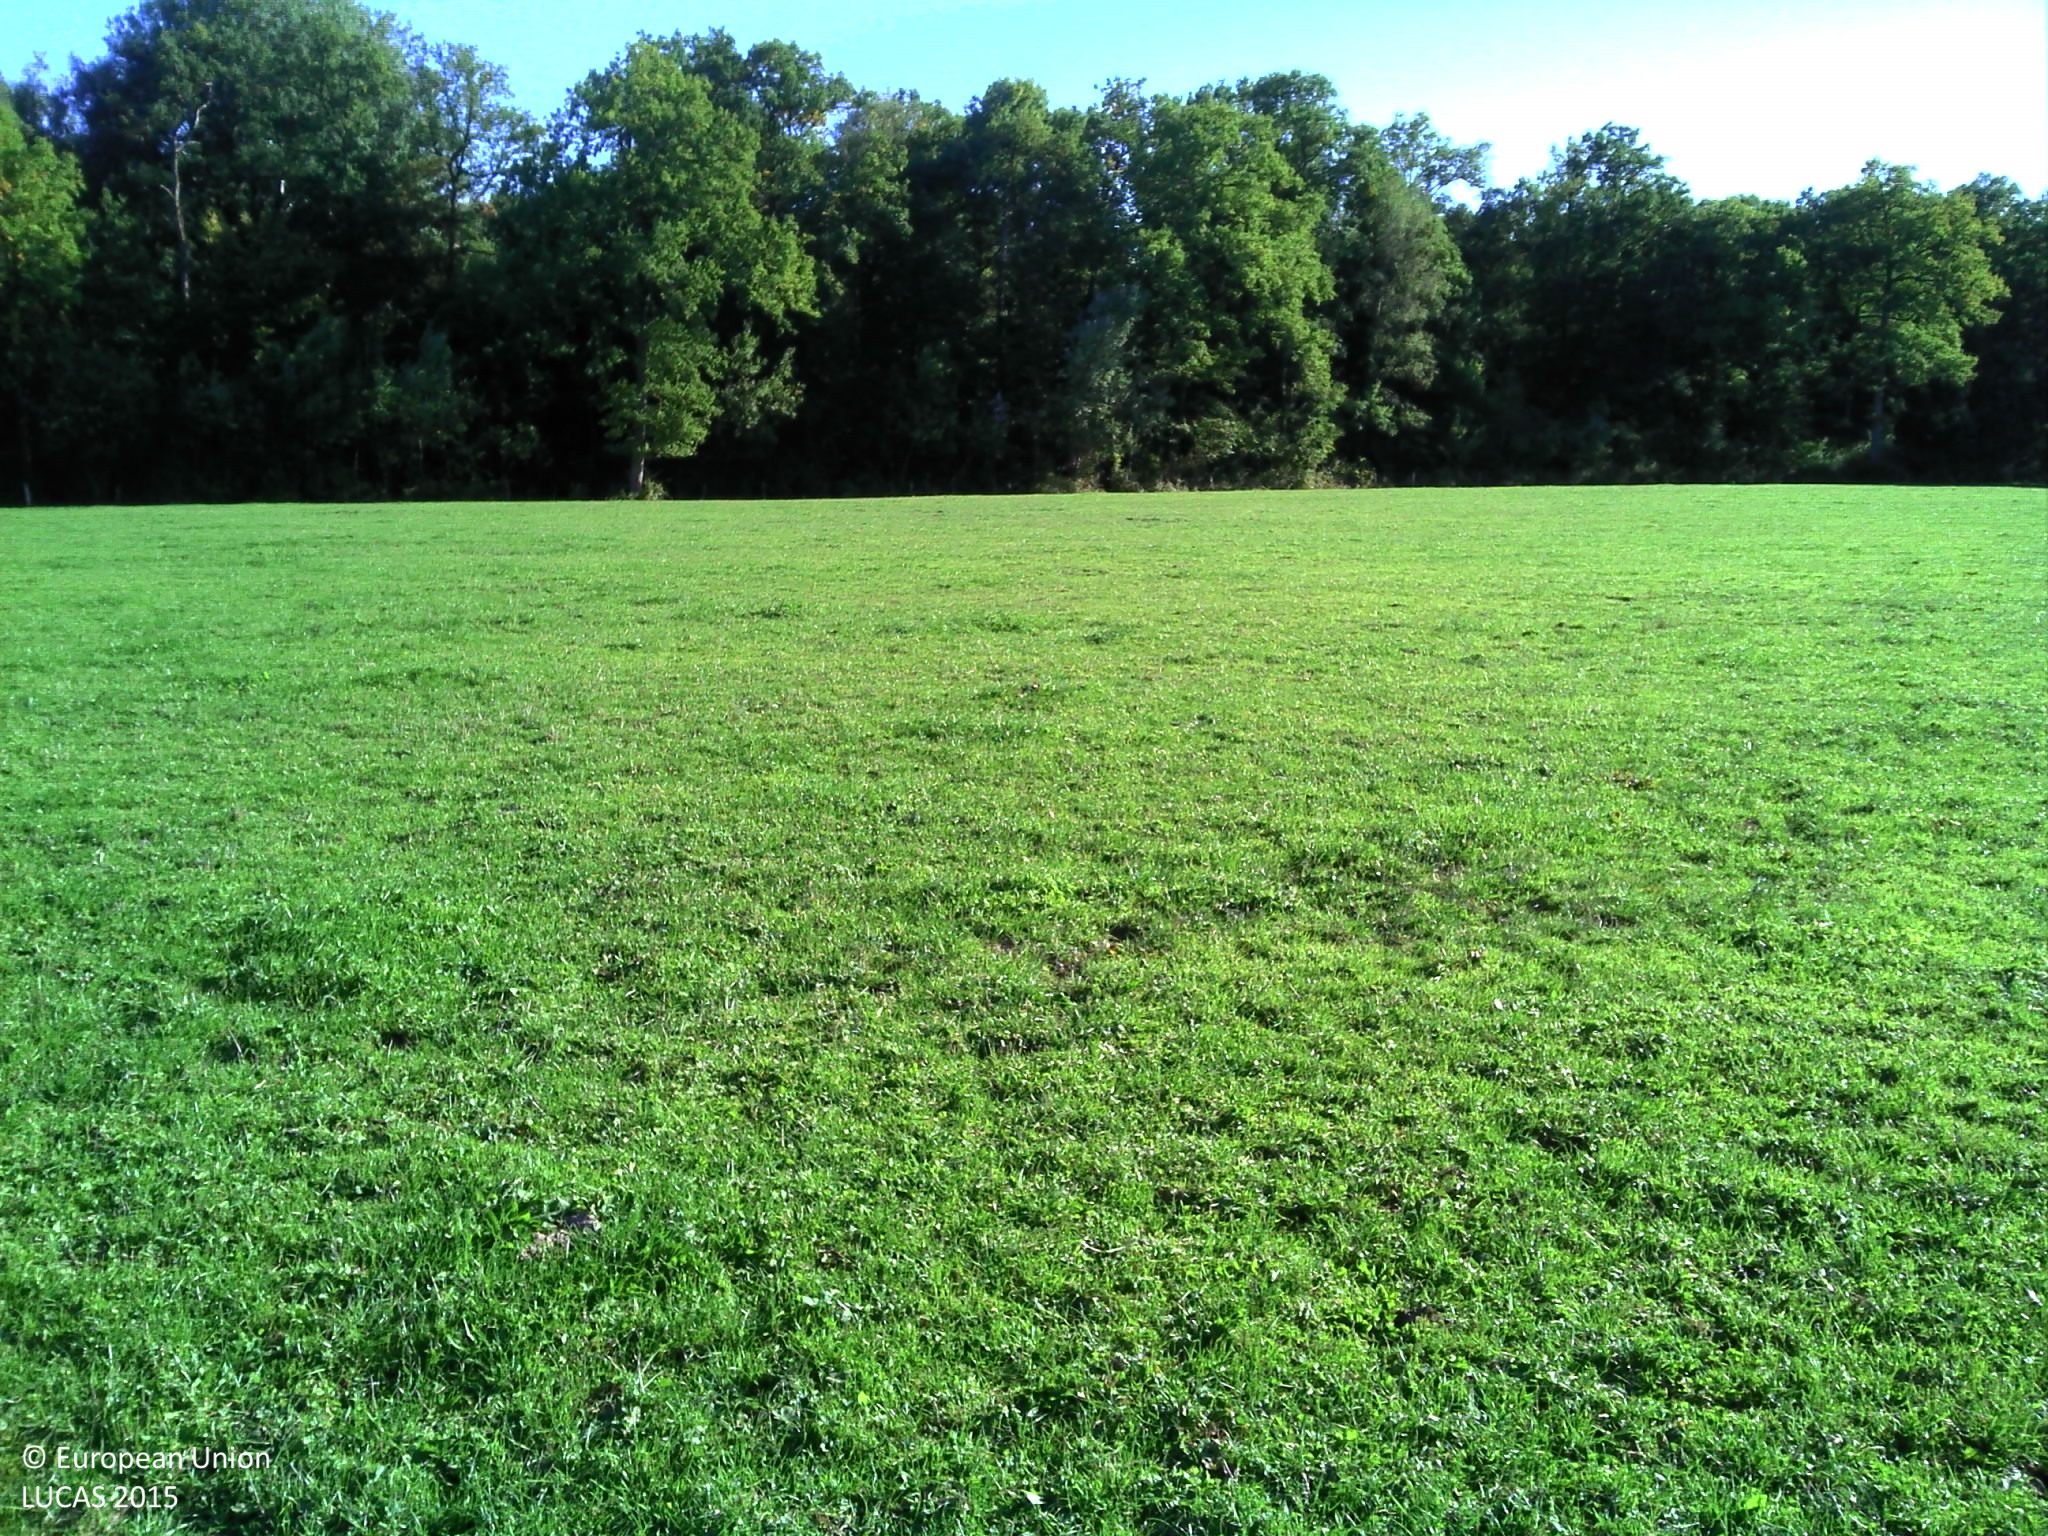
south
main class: Grassland
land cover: Grassland without tree/shrub cover
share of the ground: > 75 %
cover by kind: herbaceous plants 100 %
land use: Agriculture (excluding fallow land and kitchen gardens)
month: September
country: FR
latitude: 48.3296
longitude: 4.3183
